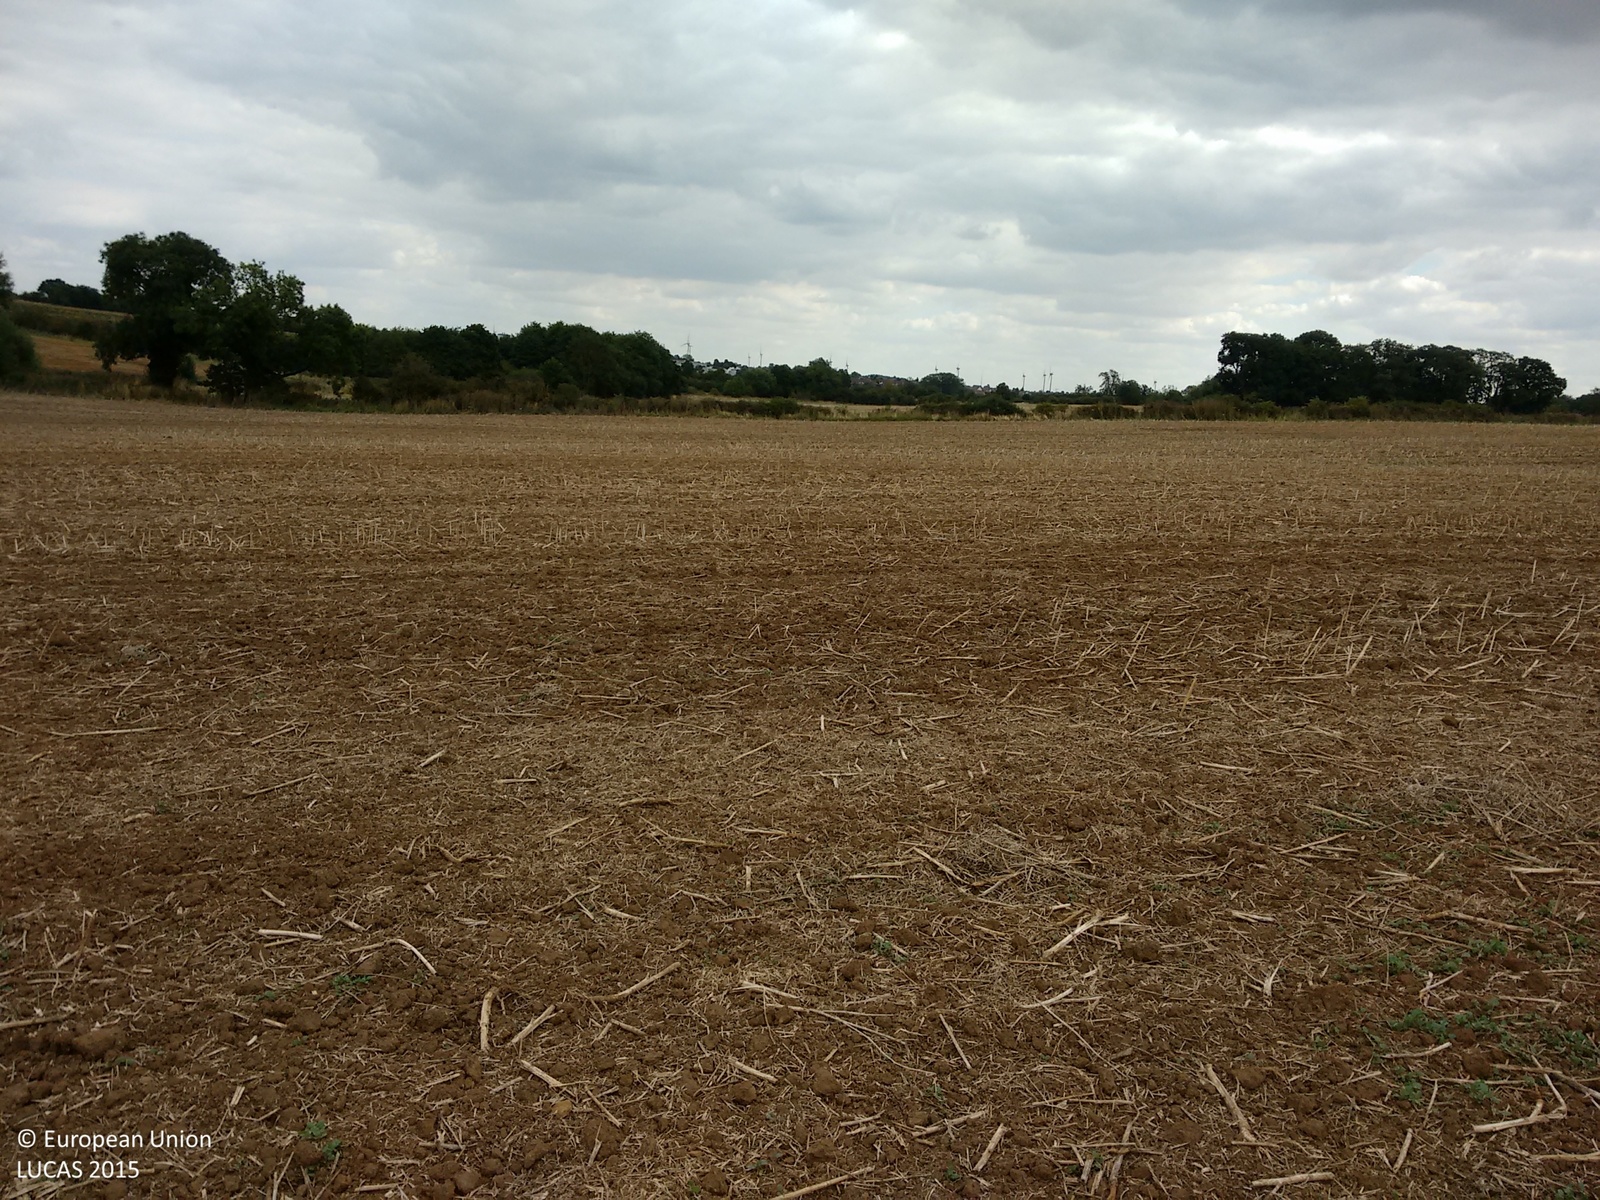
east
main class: Cropland
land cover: Rape and turnip rape
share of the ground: < 10 %
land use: Agriculture (excluding fallow land and kitchen gardens)
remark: Harvested field
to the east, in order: Rape and turnip rape; Grass margins; Abandoned hedges; Grass margins; Rape and turnip rape
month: August
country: GB
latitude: 52.3625
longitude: -0.7167
